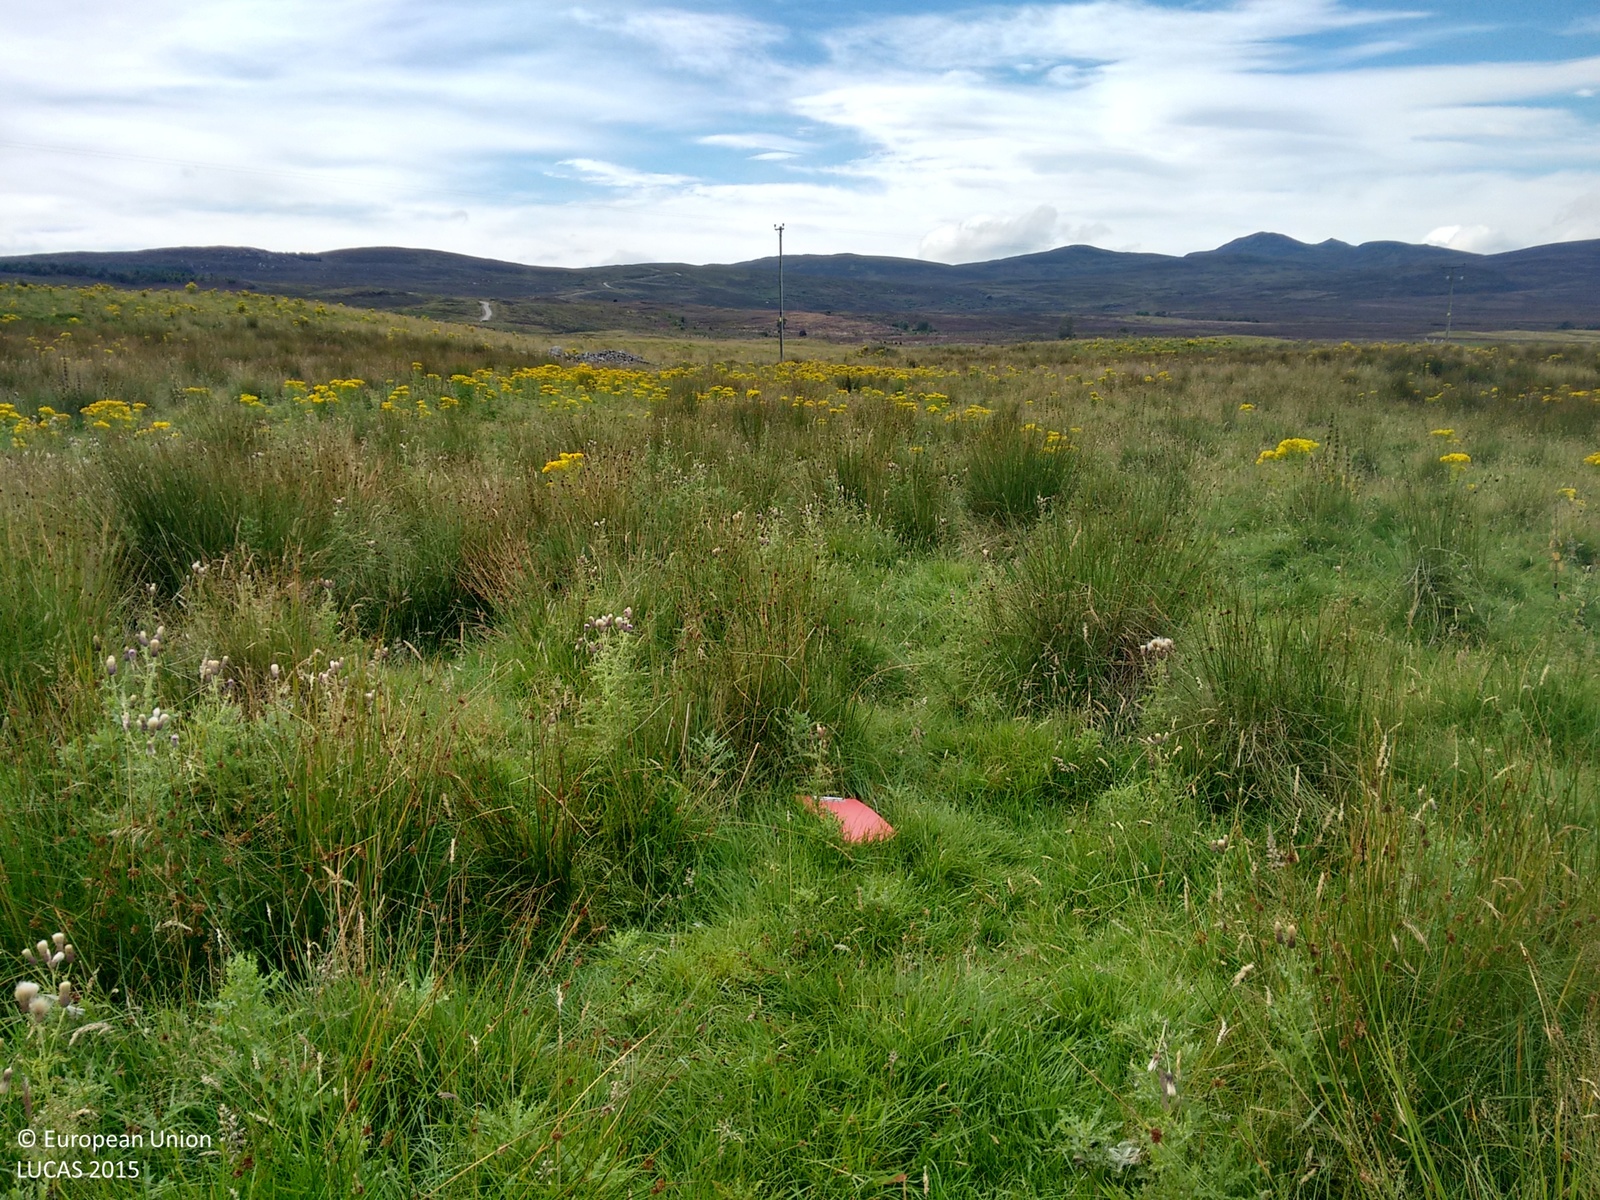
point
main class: Grassland
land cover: Grassland without tree/shrub cover
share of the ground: > 75 %
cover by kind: herbaceous plants 100 %
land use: Agriculture (excluding fallow land and kitchen gardens)
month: September
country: GB
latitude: 57.8776
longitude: -4.4024
